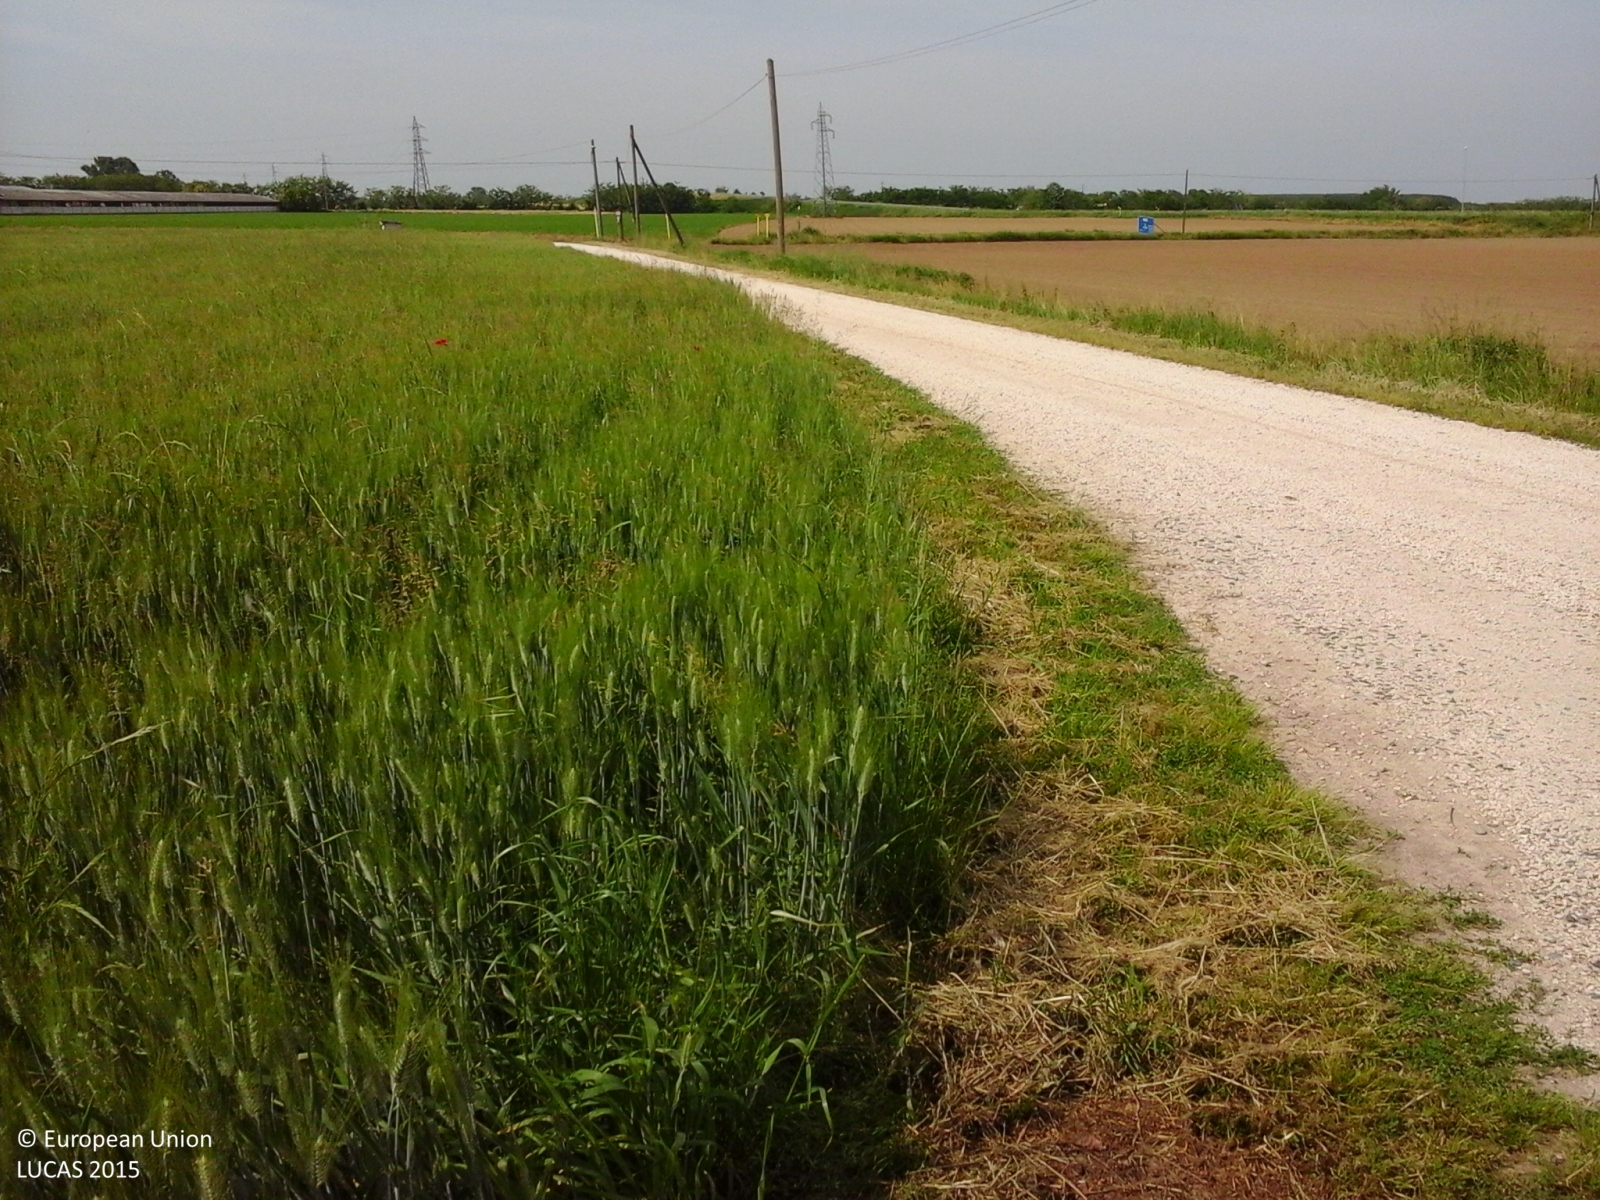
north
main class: Cropland
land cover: Barley
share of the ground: > 75 %
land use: Agriculture (excluding fallow land and kitchen gardens)
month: May
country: IT
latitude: 45.2520
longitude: 10.0636
